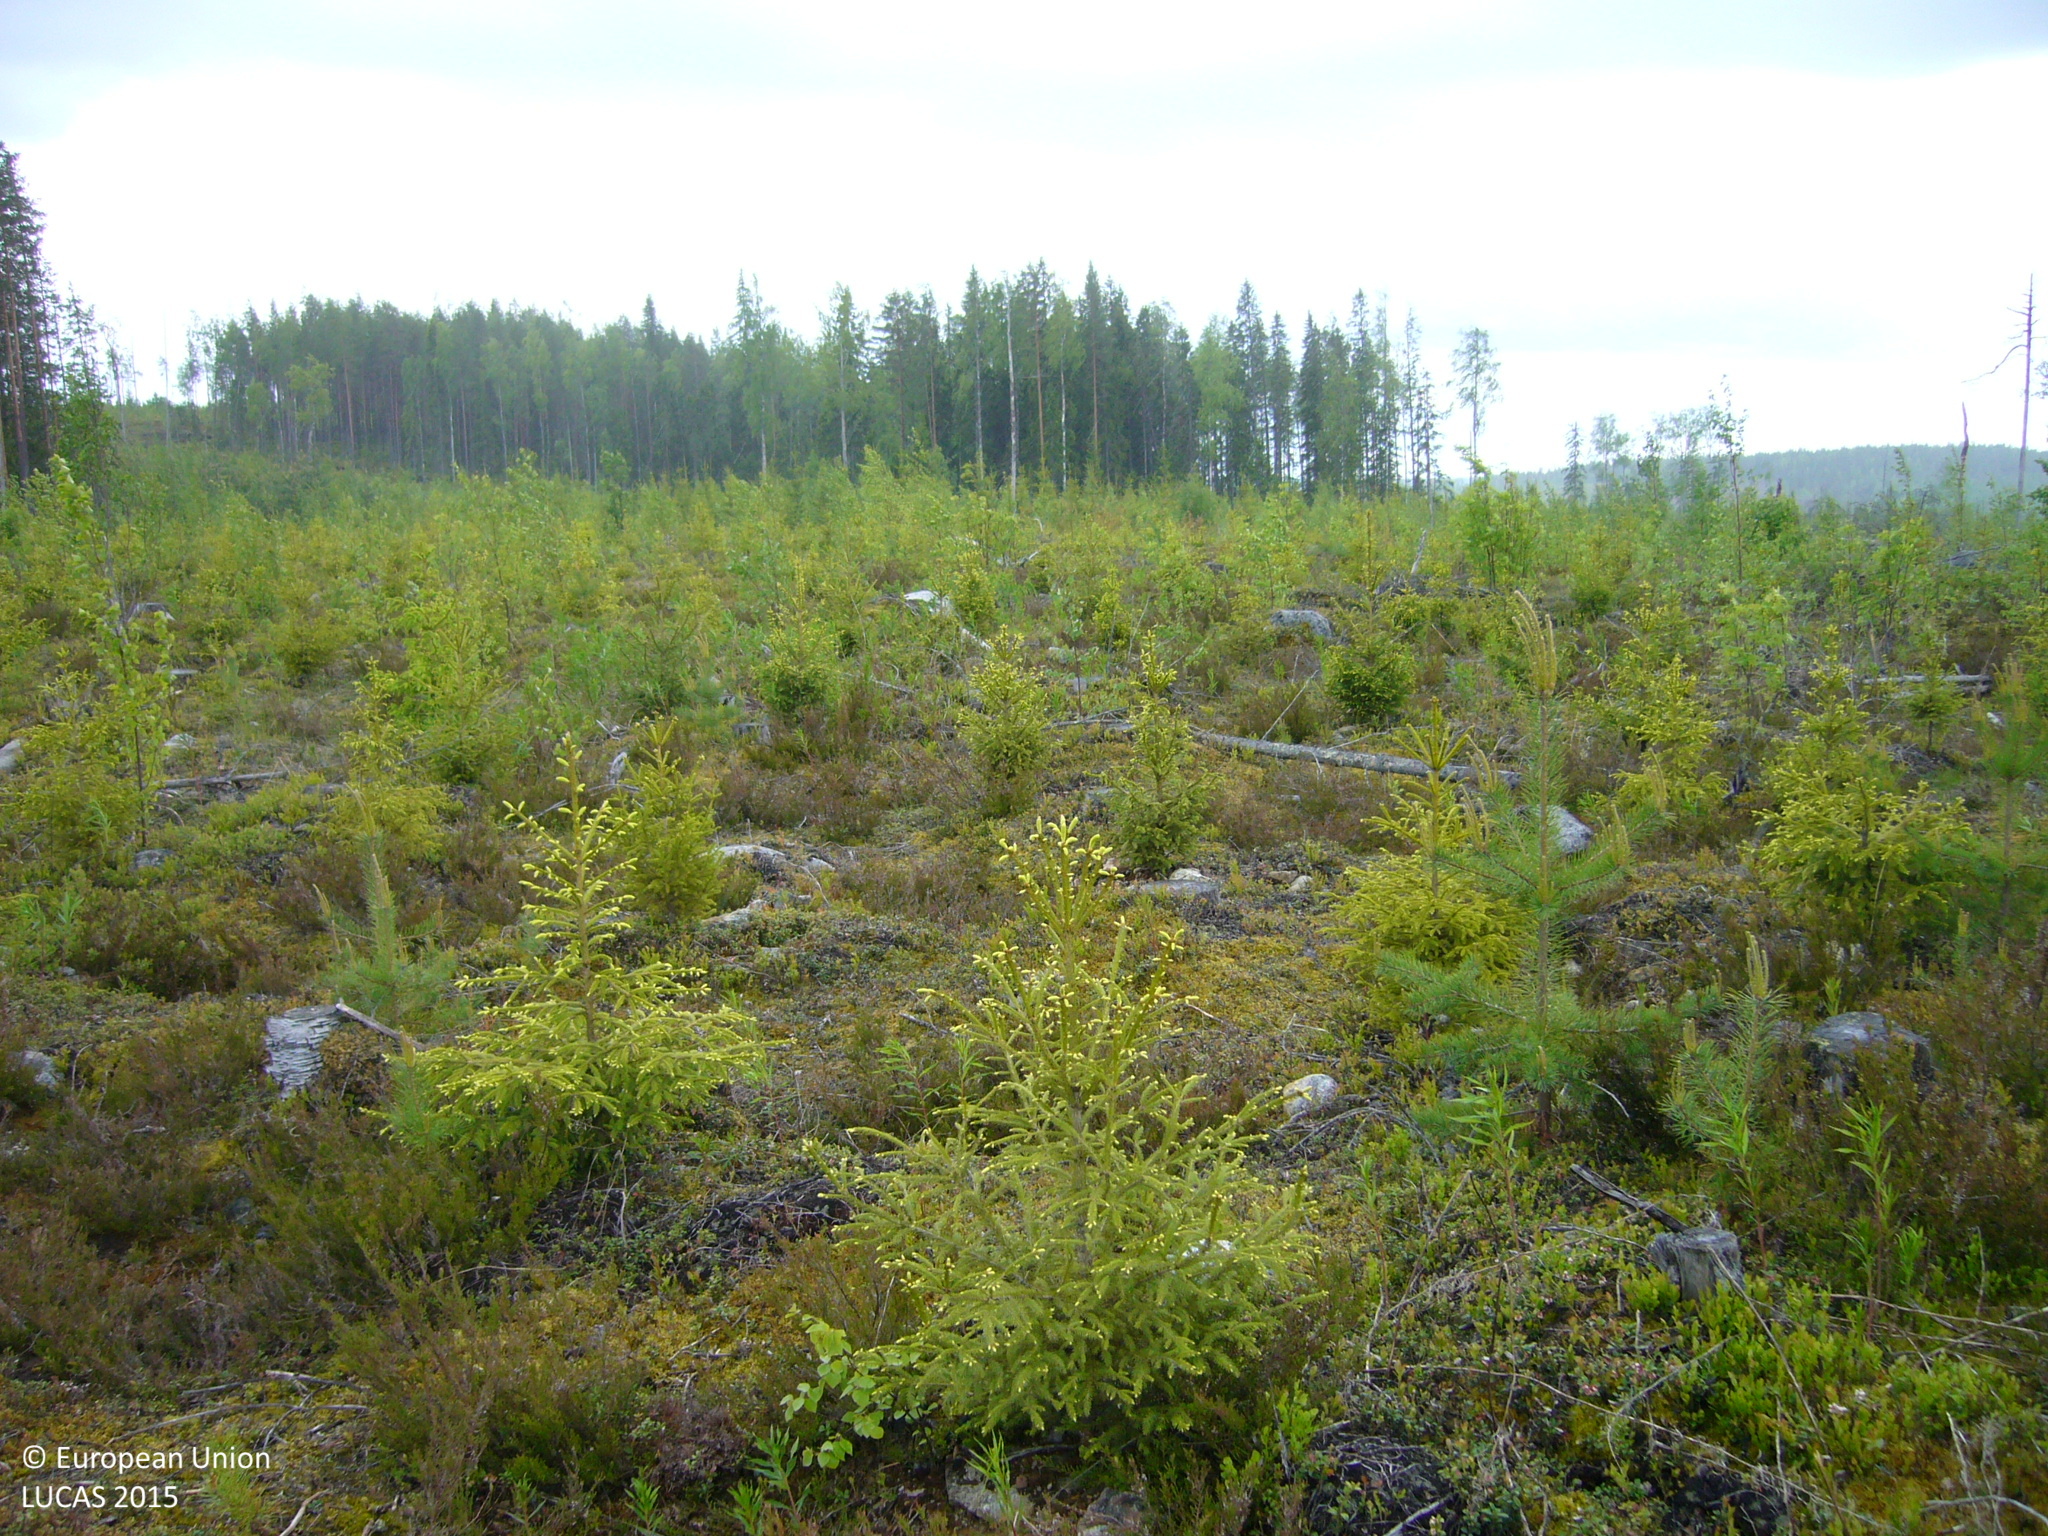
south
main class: Woodland
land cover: Spruce dominated mixed woodland
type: boreal forest
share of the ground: 25 - 50 %
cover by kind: shrubs 65 %, coniferous forest trees 20 %, broadleaved forest trees 15 %
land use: Forestry
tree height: < 5 m
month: June
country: FI
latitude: 63.8033
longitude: 27.0094
